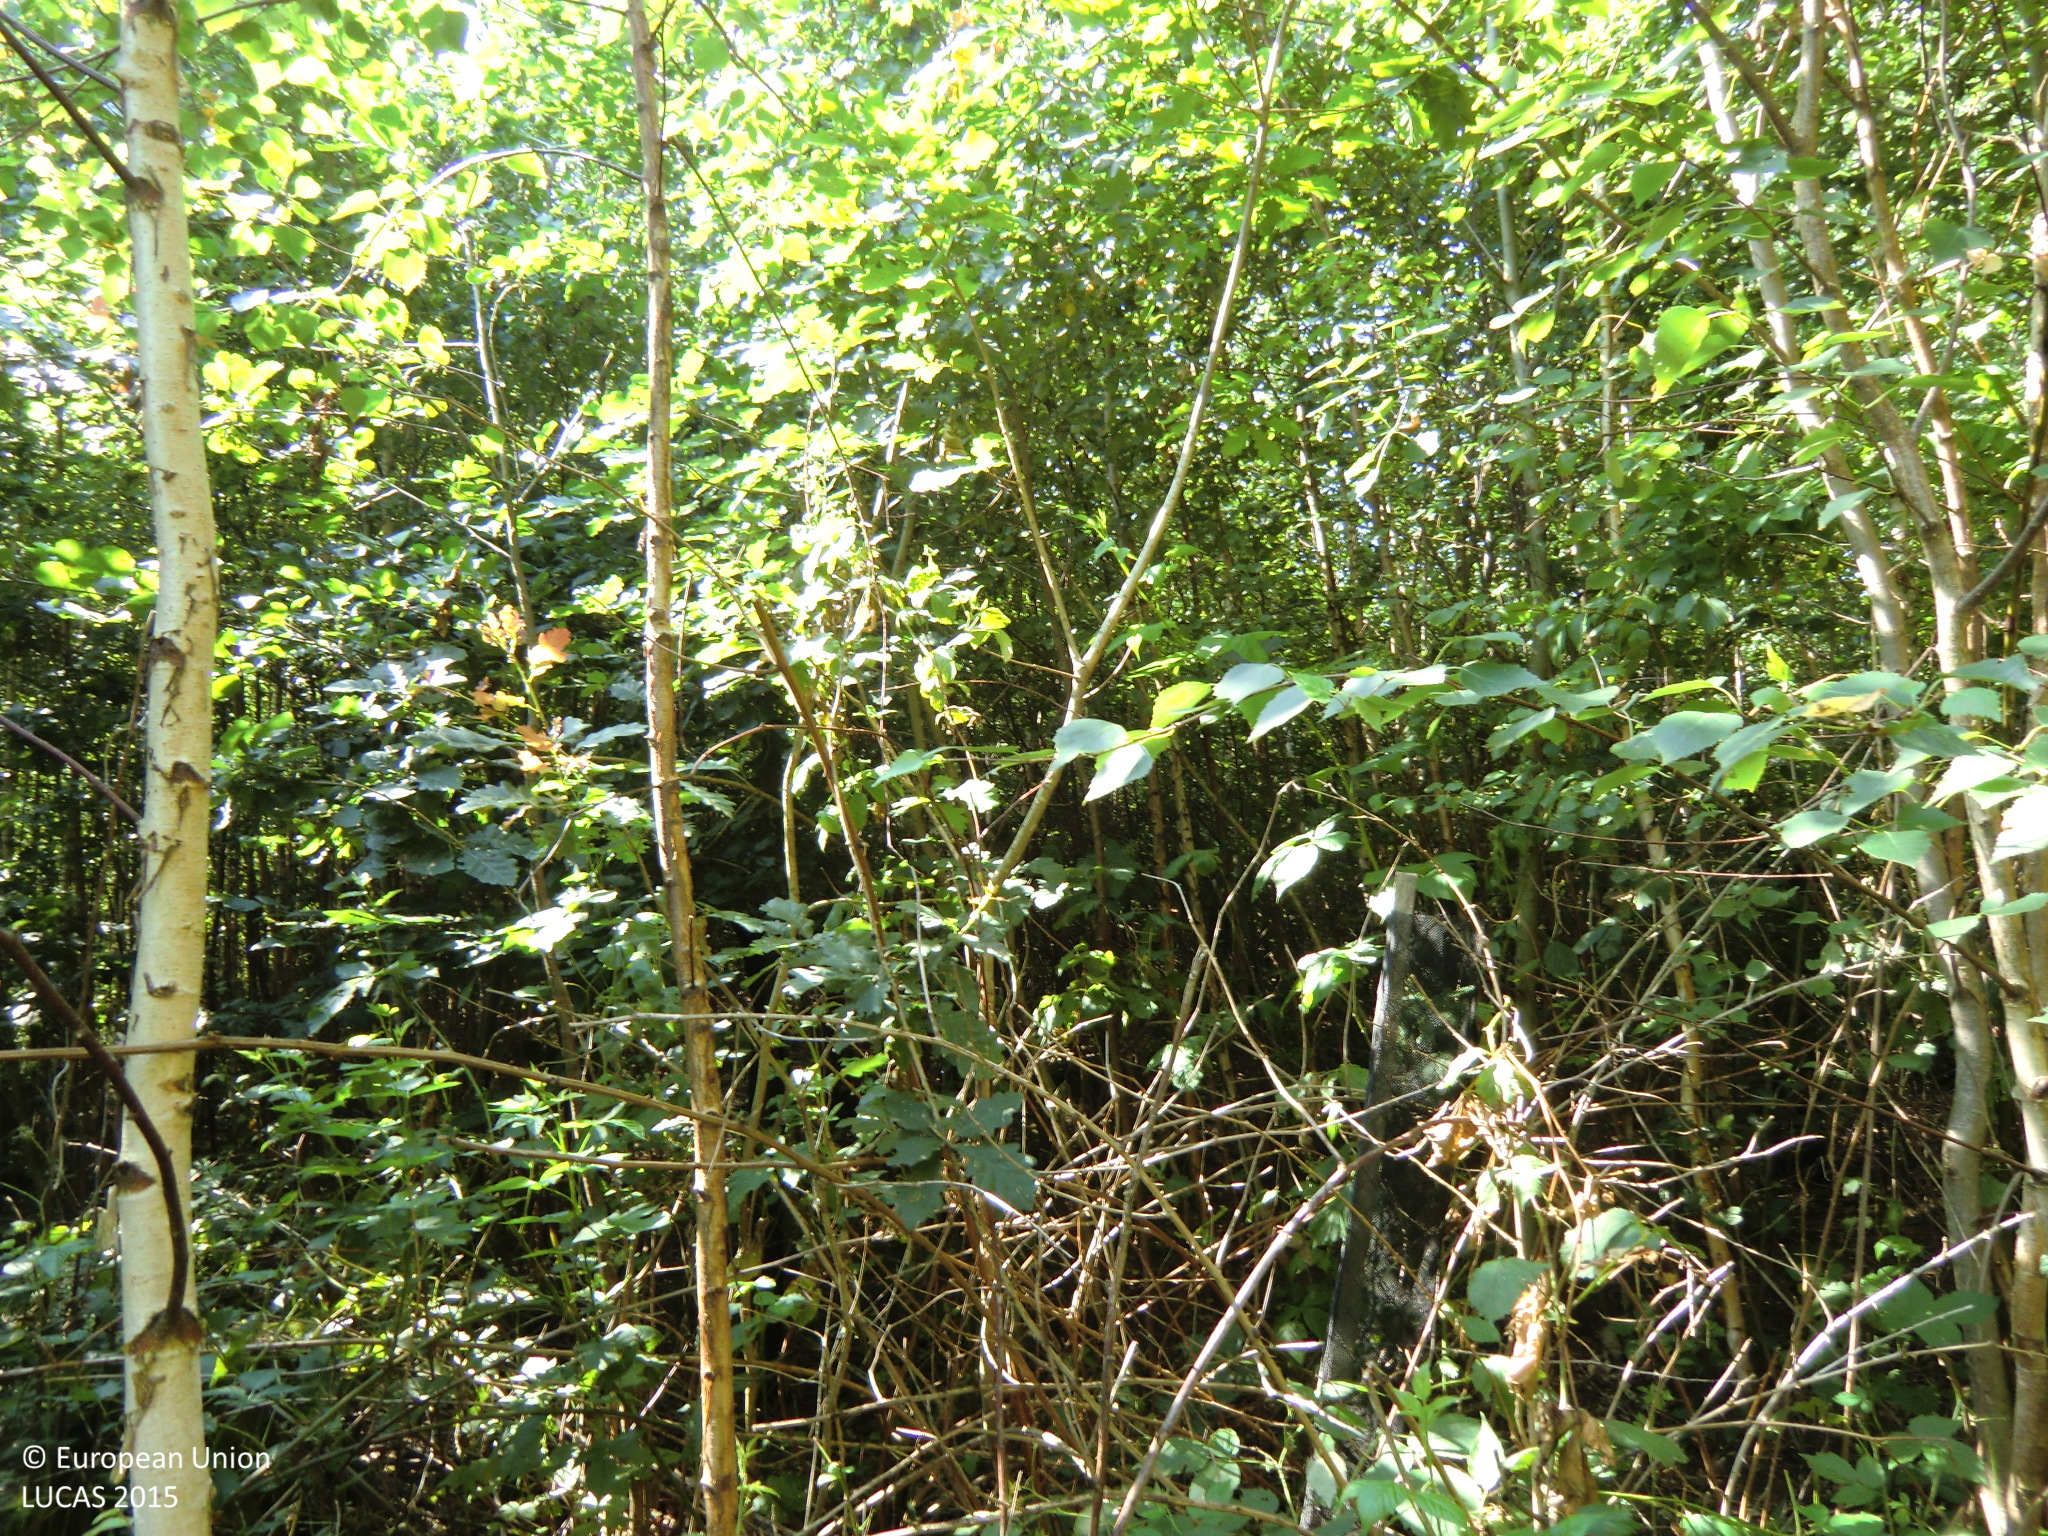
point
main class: Artificial land
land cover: Other artificial areas
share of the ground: > 75 %
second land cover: Broadleaved woodland
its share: > 75 %
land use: Electricity, gas and thermal power distribution
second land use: Forestry
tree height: > 5 m
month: July
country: AT
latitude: 47.2487
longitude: 15.9868
